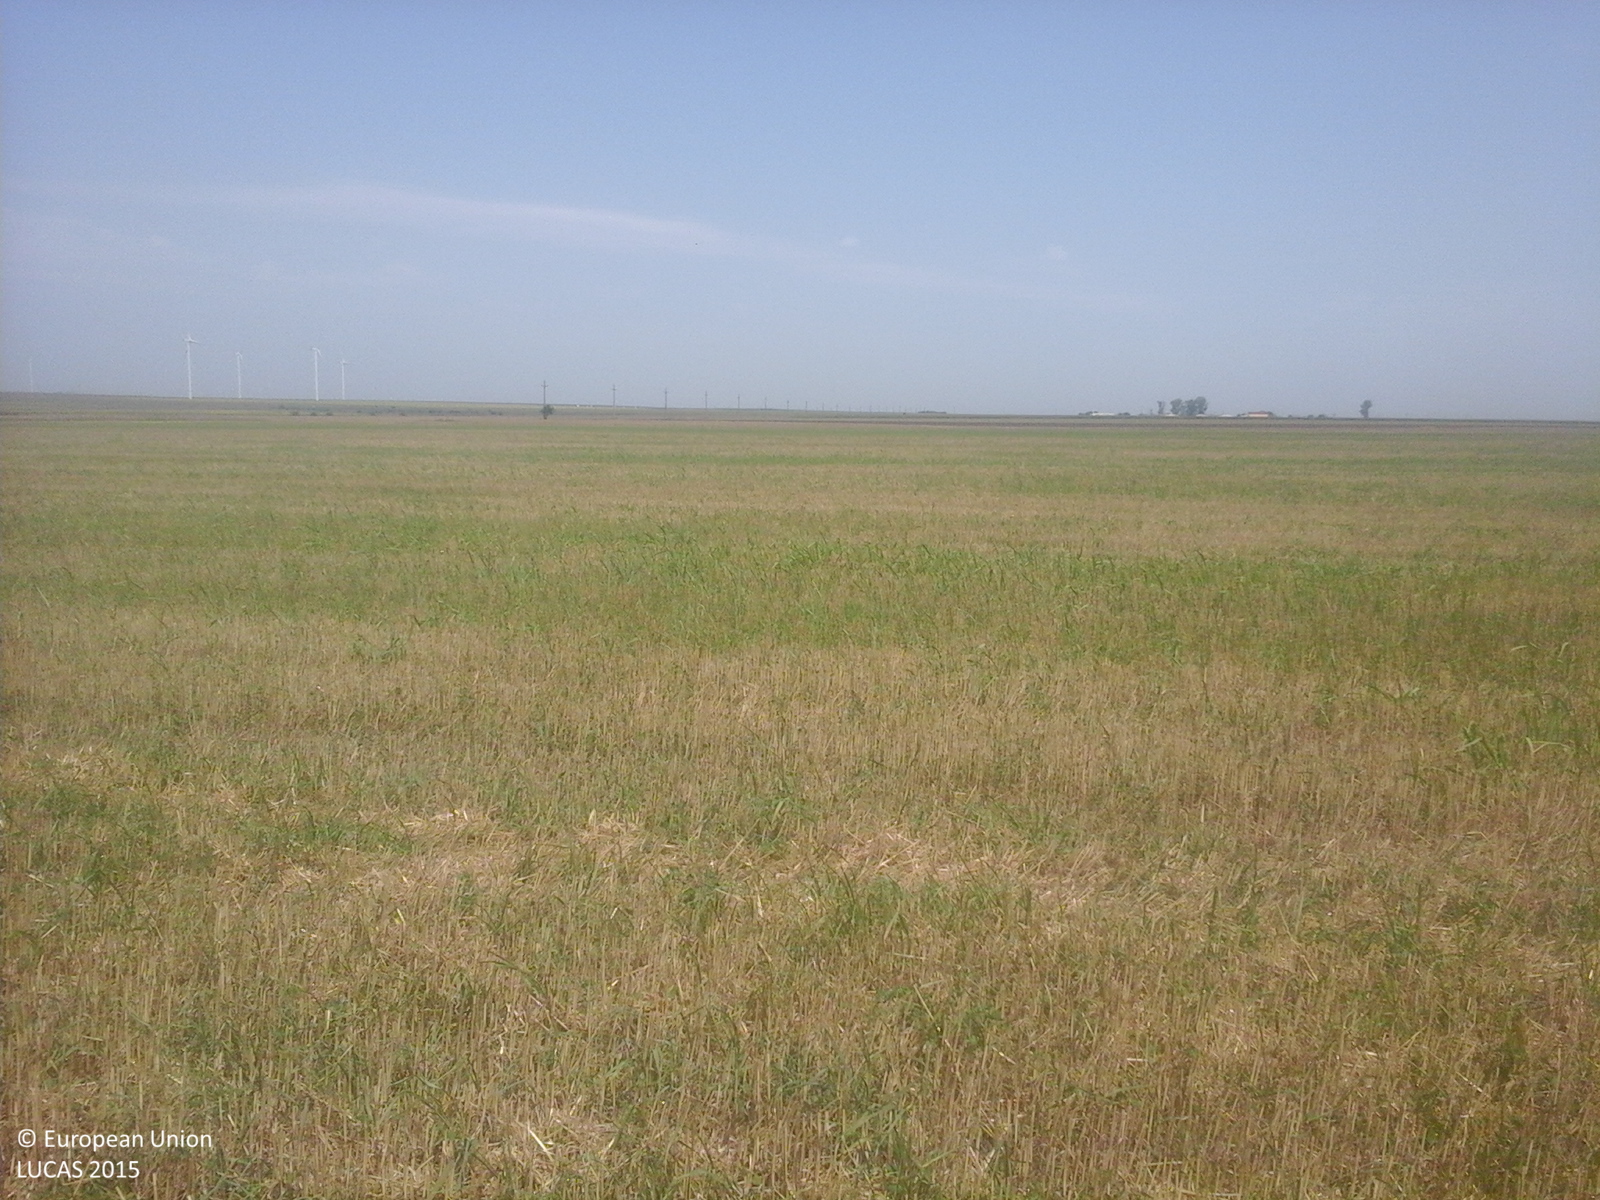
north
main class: Cropland
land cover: Durum wheat
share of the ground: > 75 %
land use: Agriculture (excluding fallow land and kitchen gardens)
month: August
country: RO
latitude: 43.8664
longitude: 28.2115
